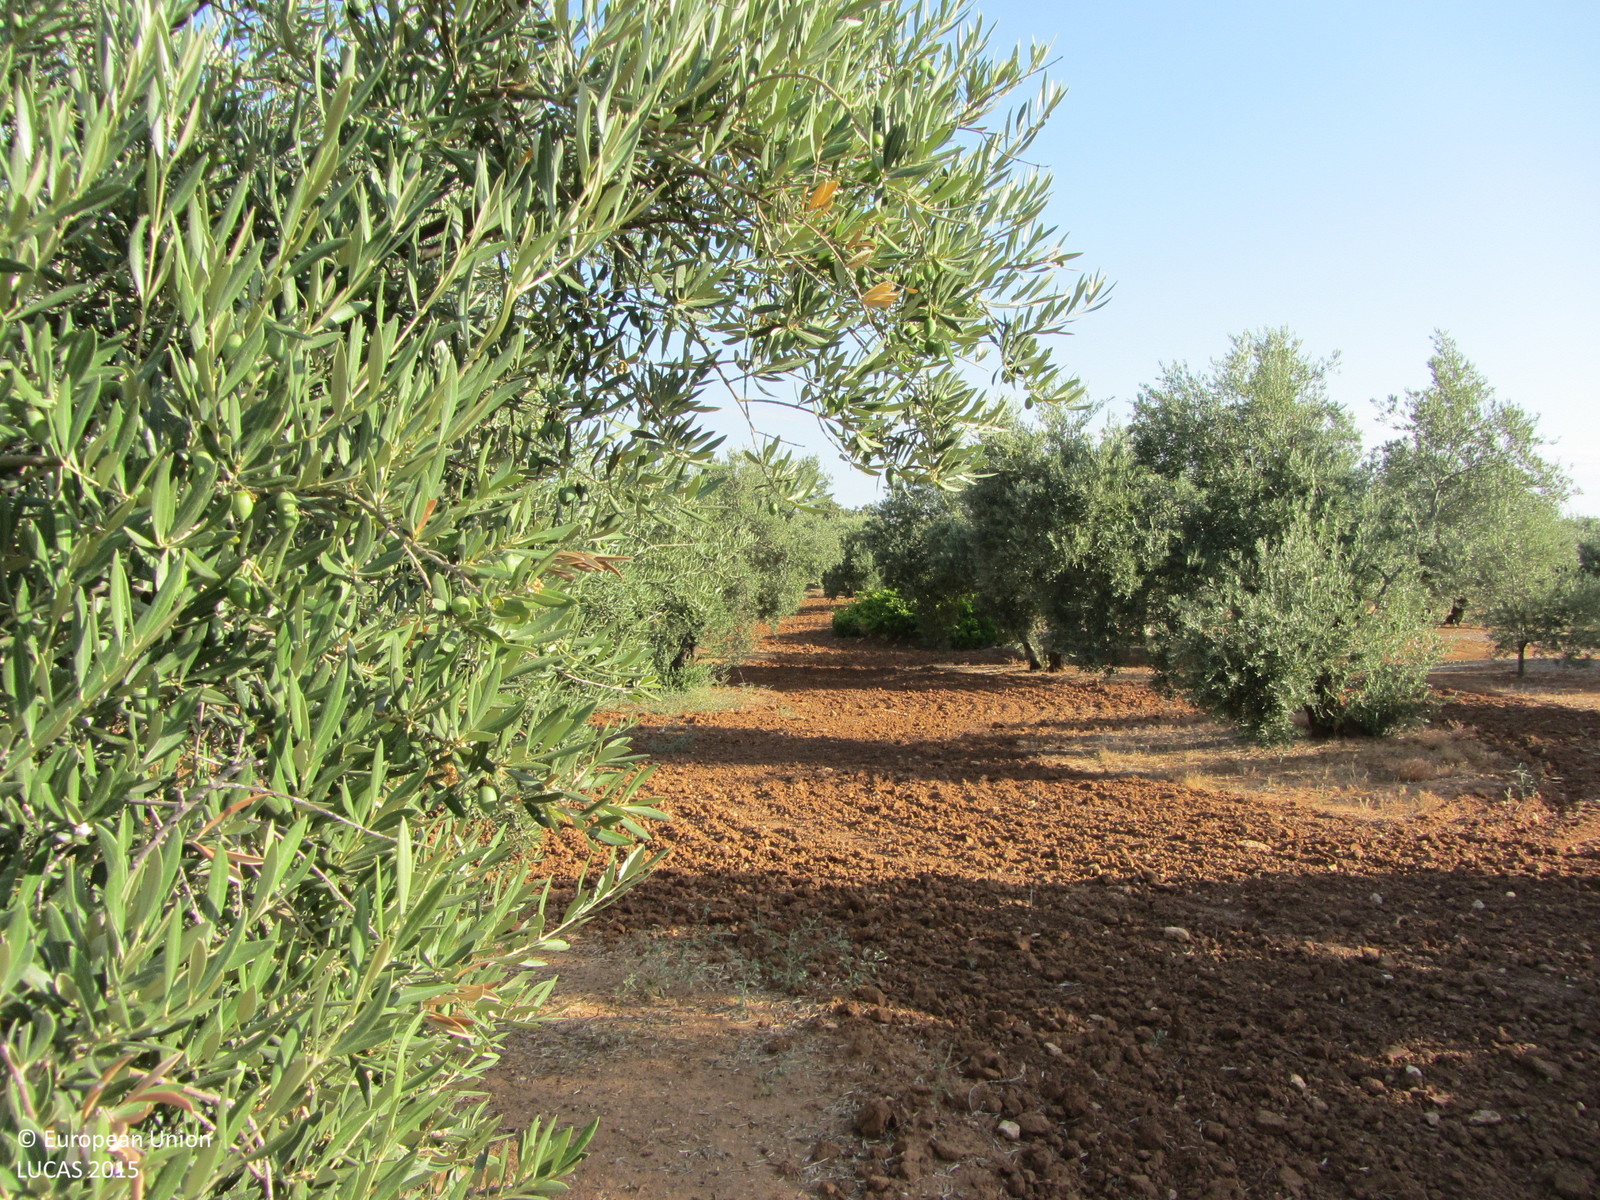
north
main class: Cropland
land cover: Olive groves
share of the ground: 25 - 50 %
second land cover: Other bare soil
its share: > 75 %
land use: Agriculture (excluding fallow land and kitchen gardens)
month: July
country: ES
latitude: 38.0552
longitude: -3.4378
